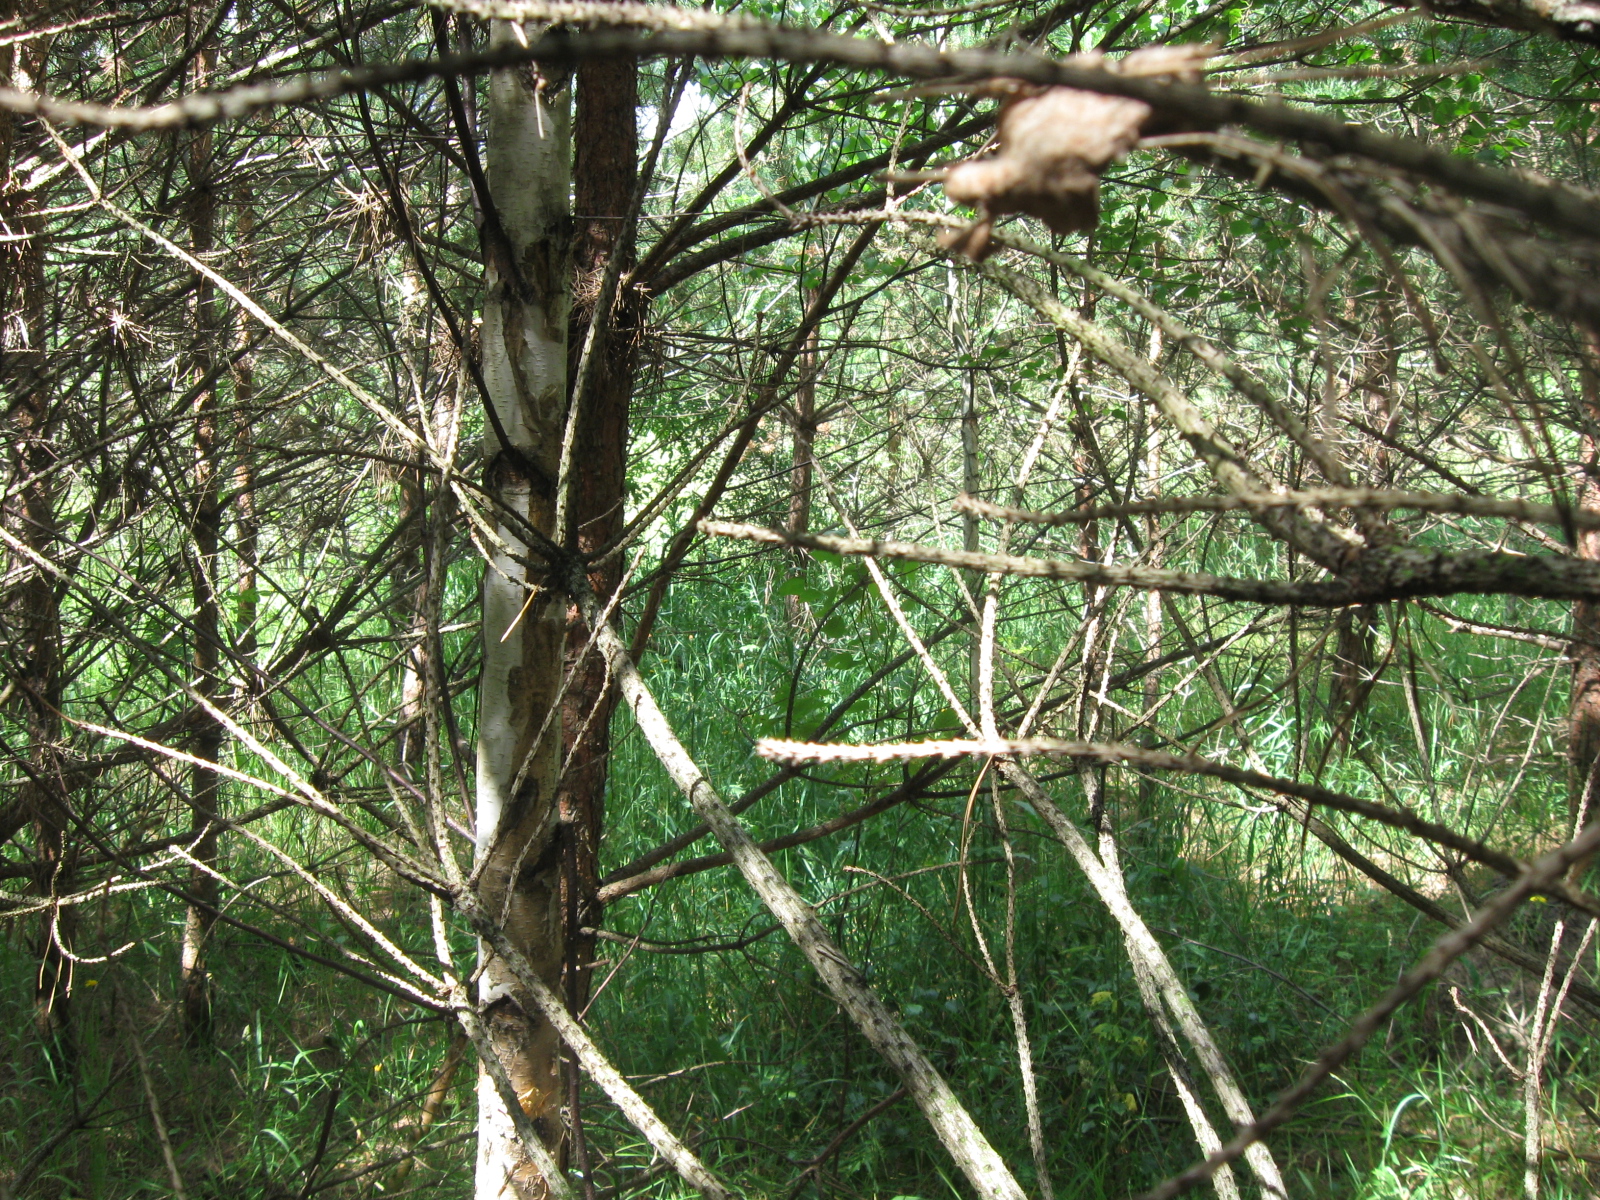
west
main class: Woodland
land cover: Pine dominated coniferous woodland
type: hemiboreal forest and nemoral coniferous forest and mixed broadleaved-coniferous forest
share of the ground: > 75 %
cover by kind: coniferous forest trees 95 %, herbaceous plants 5 %
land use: Forestry
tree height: < 5 m
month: July
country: LT
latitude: 54.3632
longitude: 24.5558
